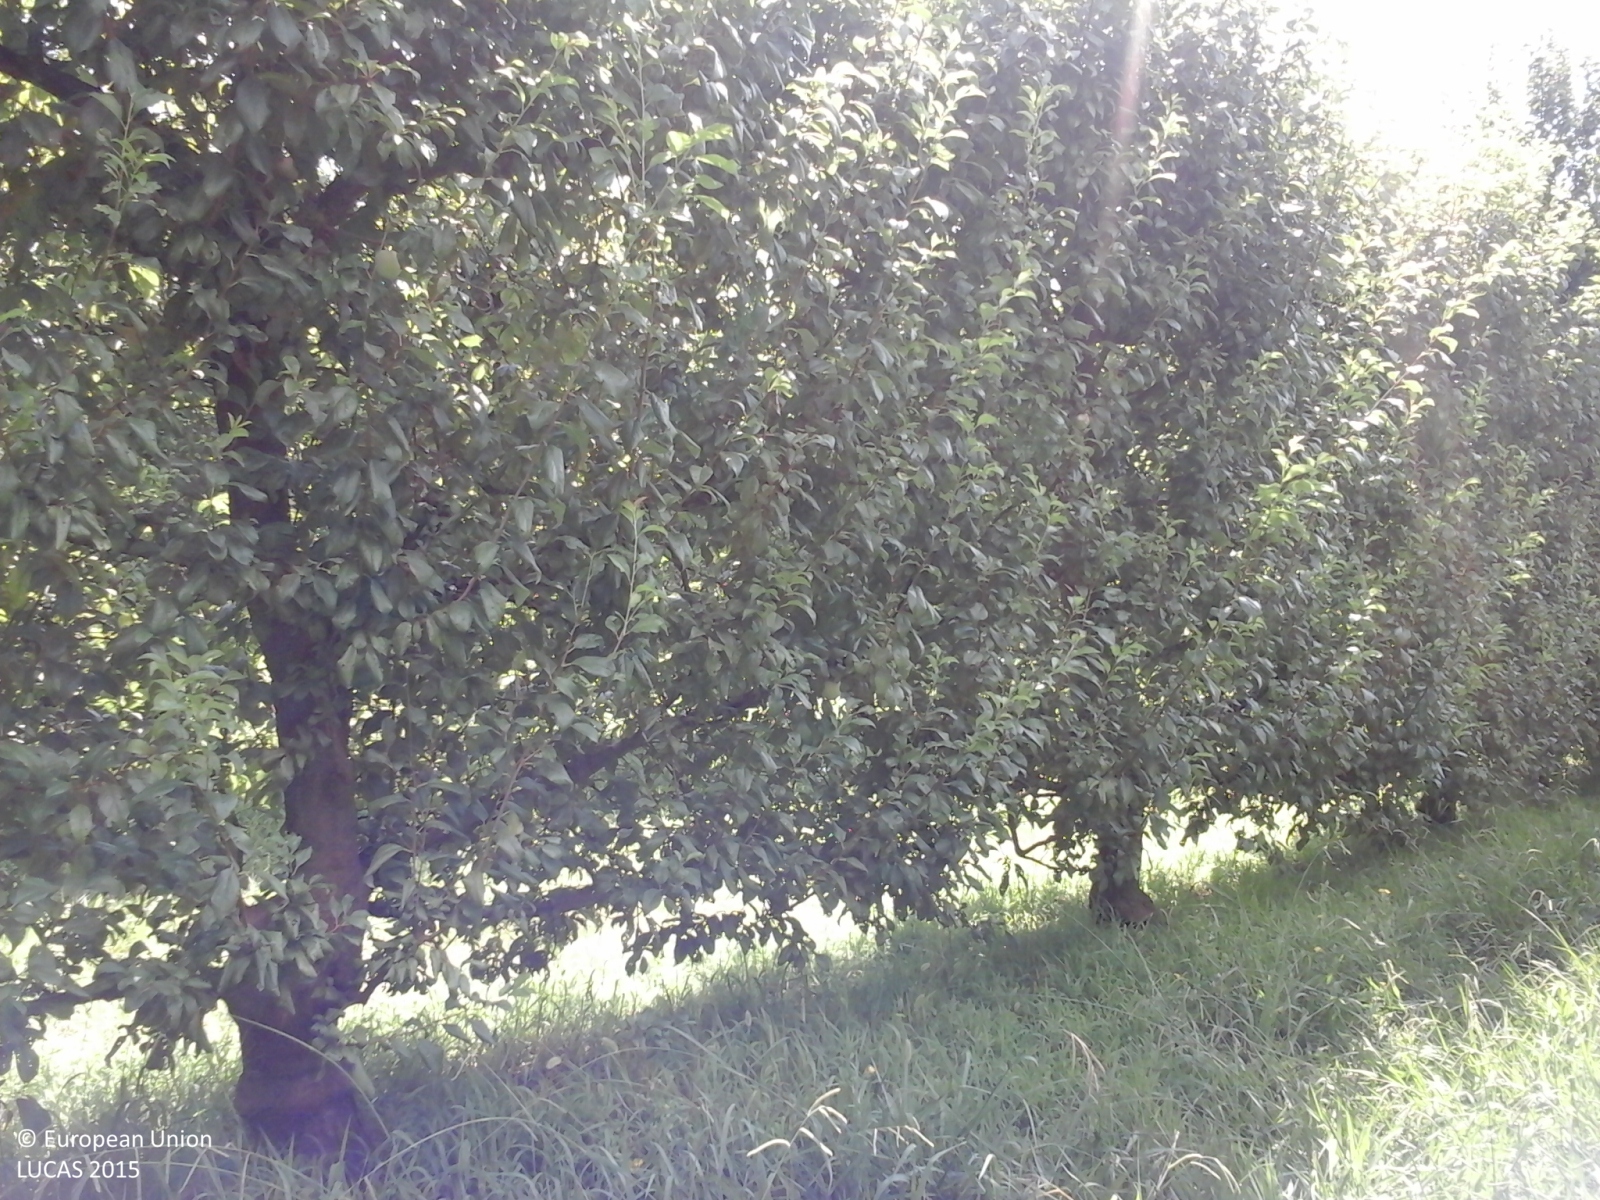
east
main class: Cropland
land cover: Other fruit trees and berries
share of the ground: 25 - 50 %
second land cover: Spontaneously vegetated surfaces
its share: > 75 %
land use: Agriculture (excluding fallow land and kitchen gardens)
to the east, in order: Other fruit trees and berries; Spontaneously vegetated surfaces; Grass margins; Ditches and canals; Lucerne; Ditches and canals; Lucerne; Tracks; Ditches and canals; Other bare soil
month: July
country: IT
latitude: 41.4916
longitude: 12.8991
